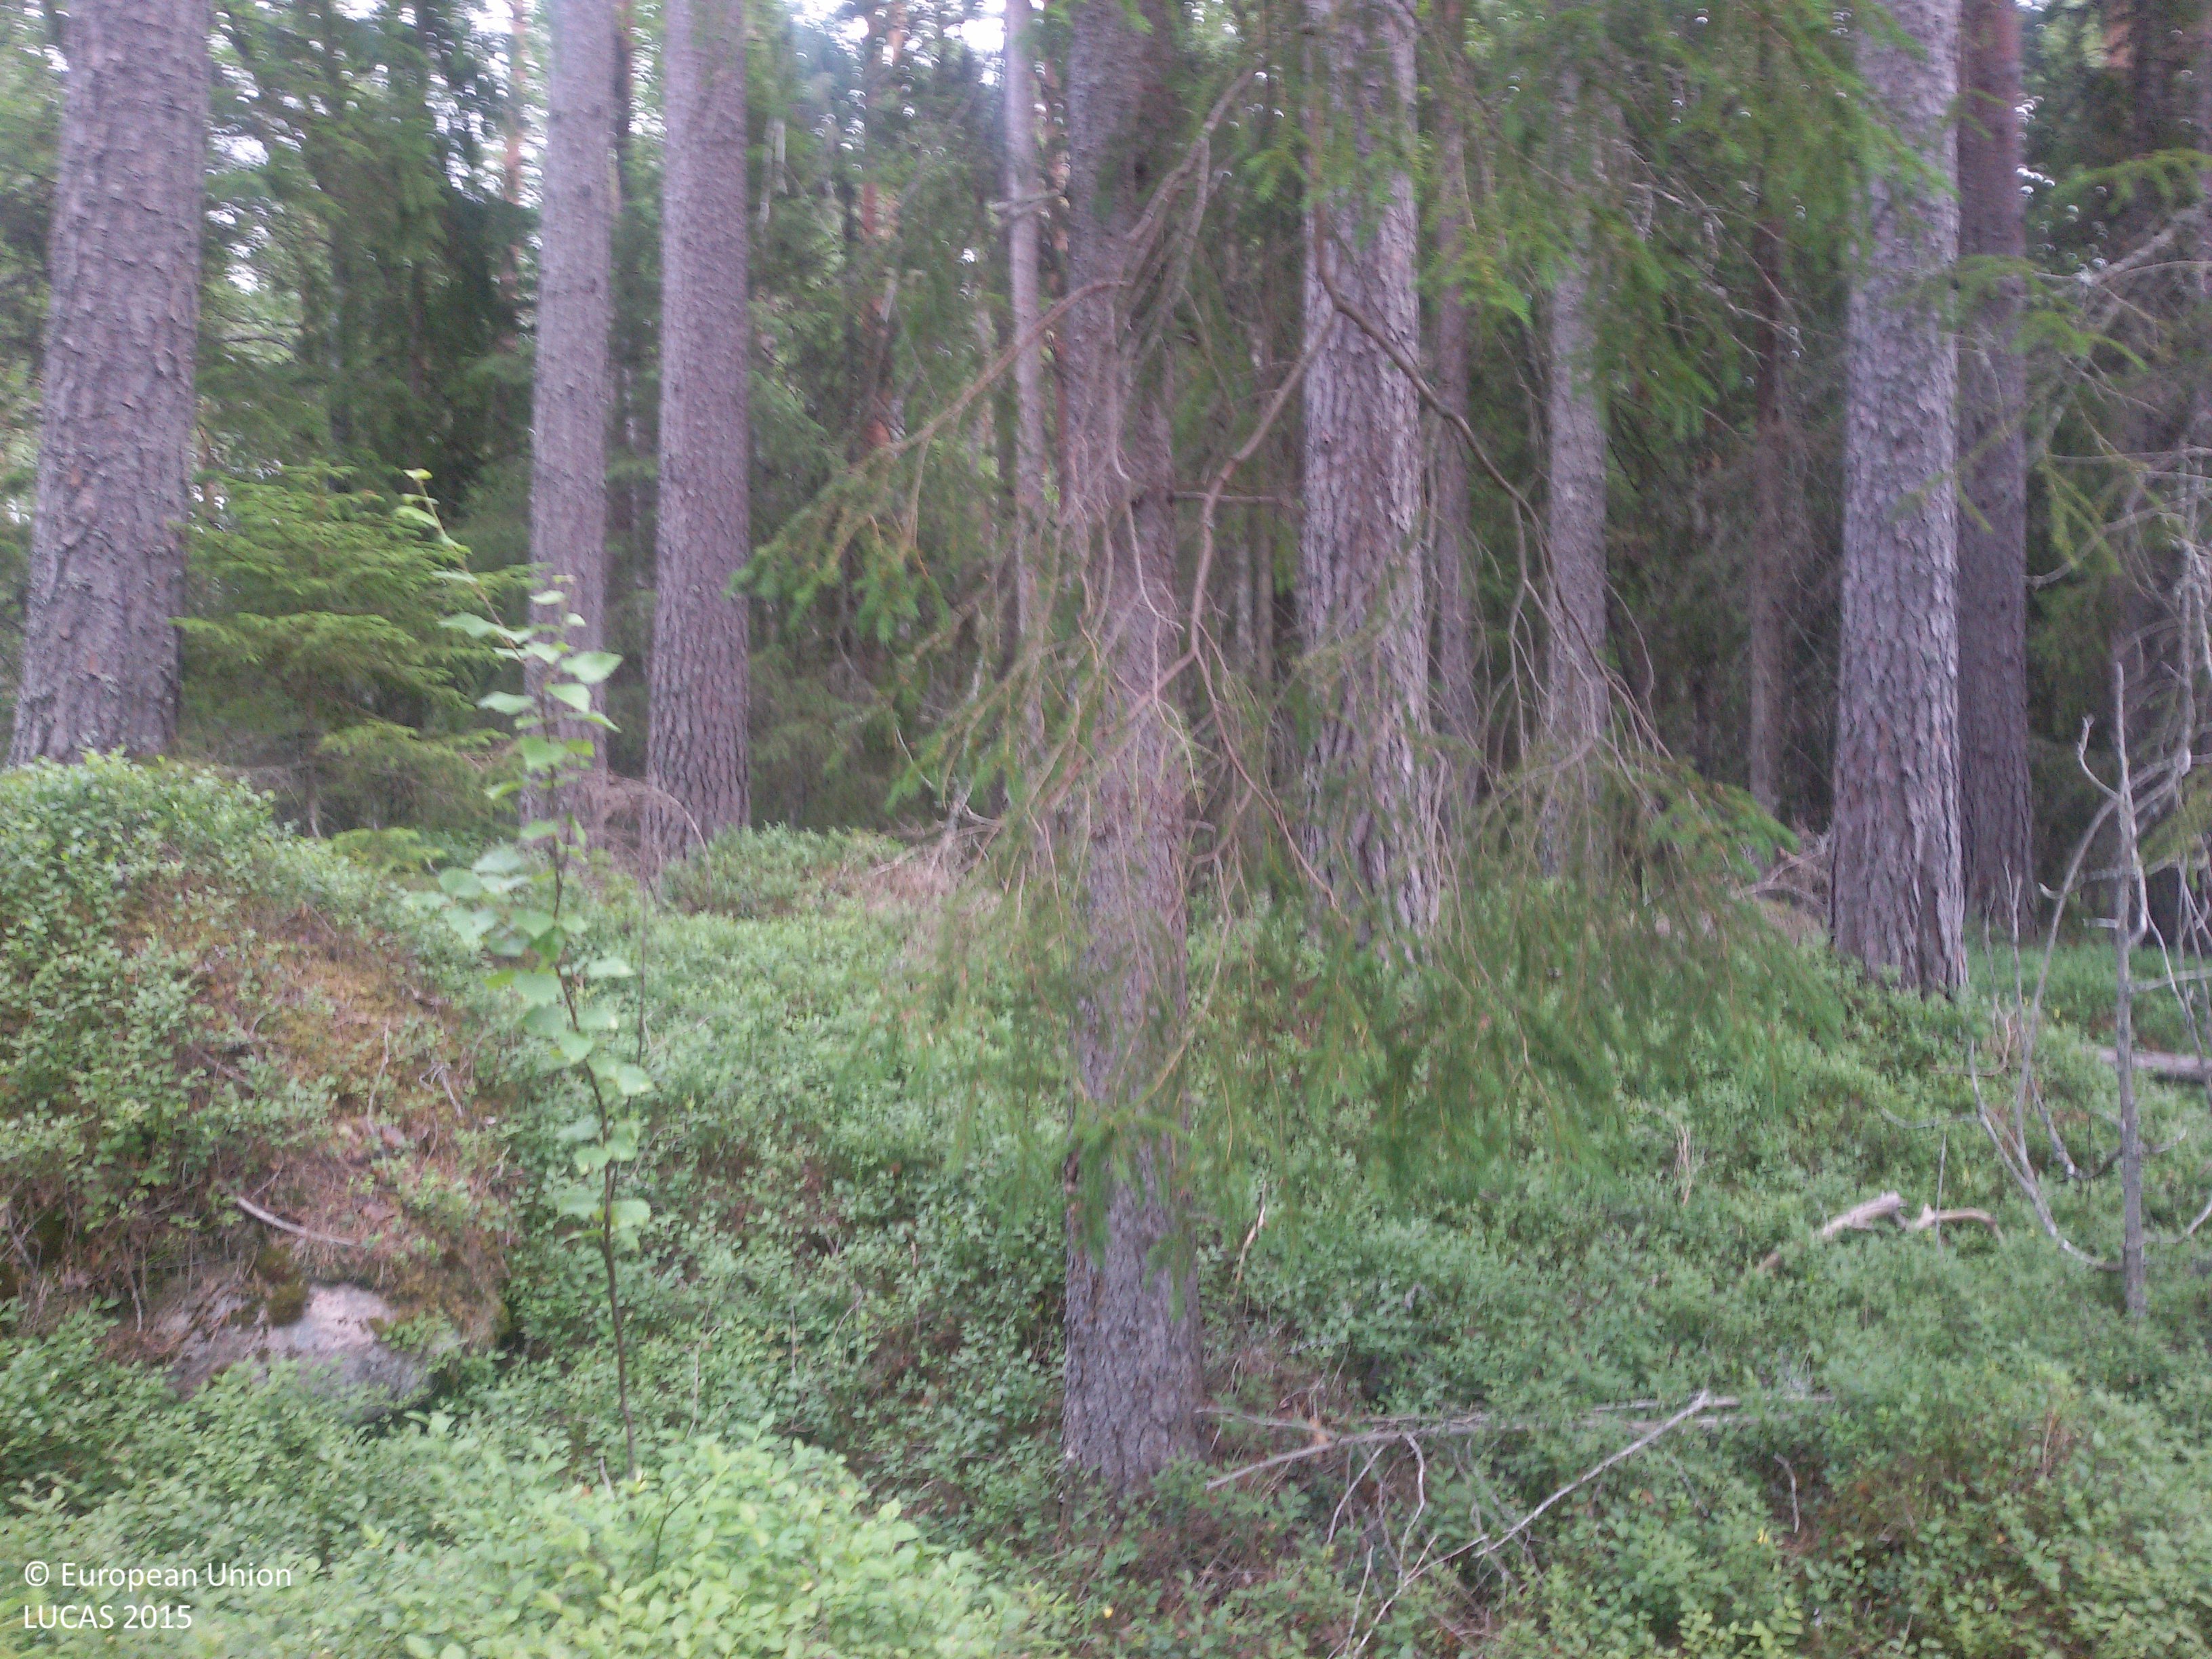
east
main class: Woodland
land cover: Spruce dominated coniferous woodland
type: boreal forest
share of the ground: 50 - 75 %
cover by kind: coniferous forest trees 75 %, shrubs 25 %
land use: Forestry
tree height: > 5 m
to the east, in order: Spruce dominated coniferous woodland; Inland fresh running water; Spruce dominated coniferous woodland; Inland fresh running water; Spruce dominated coniferous woodland; Rivers and streams; Spruce dominated coniferous woodland; Pine dominated coniferous woodland
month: July
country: SE
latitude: 60.4636
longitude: 15.2070
